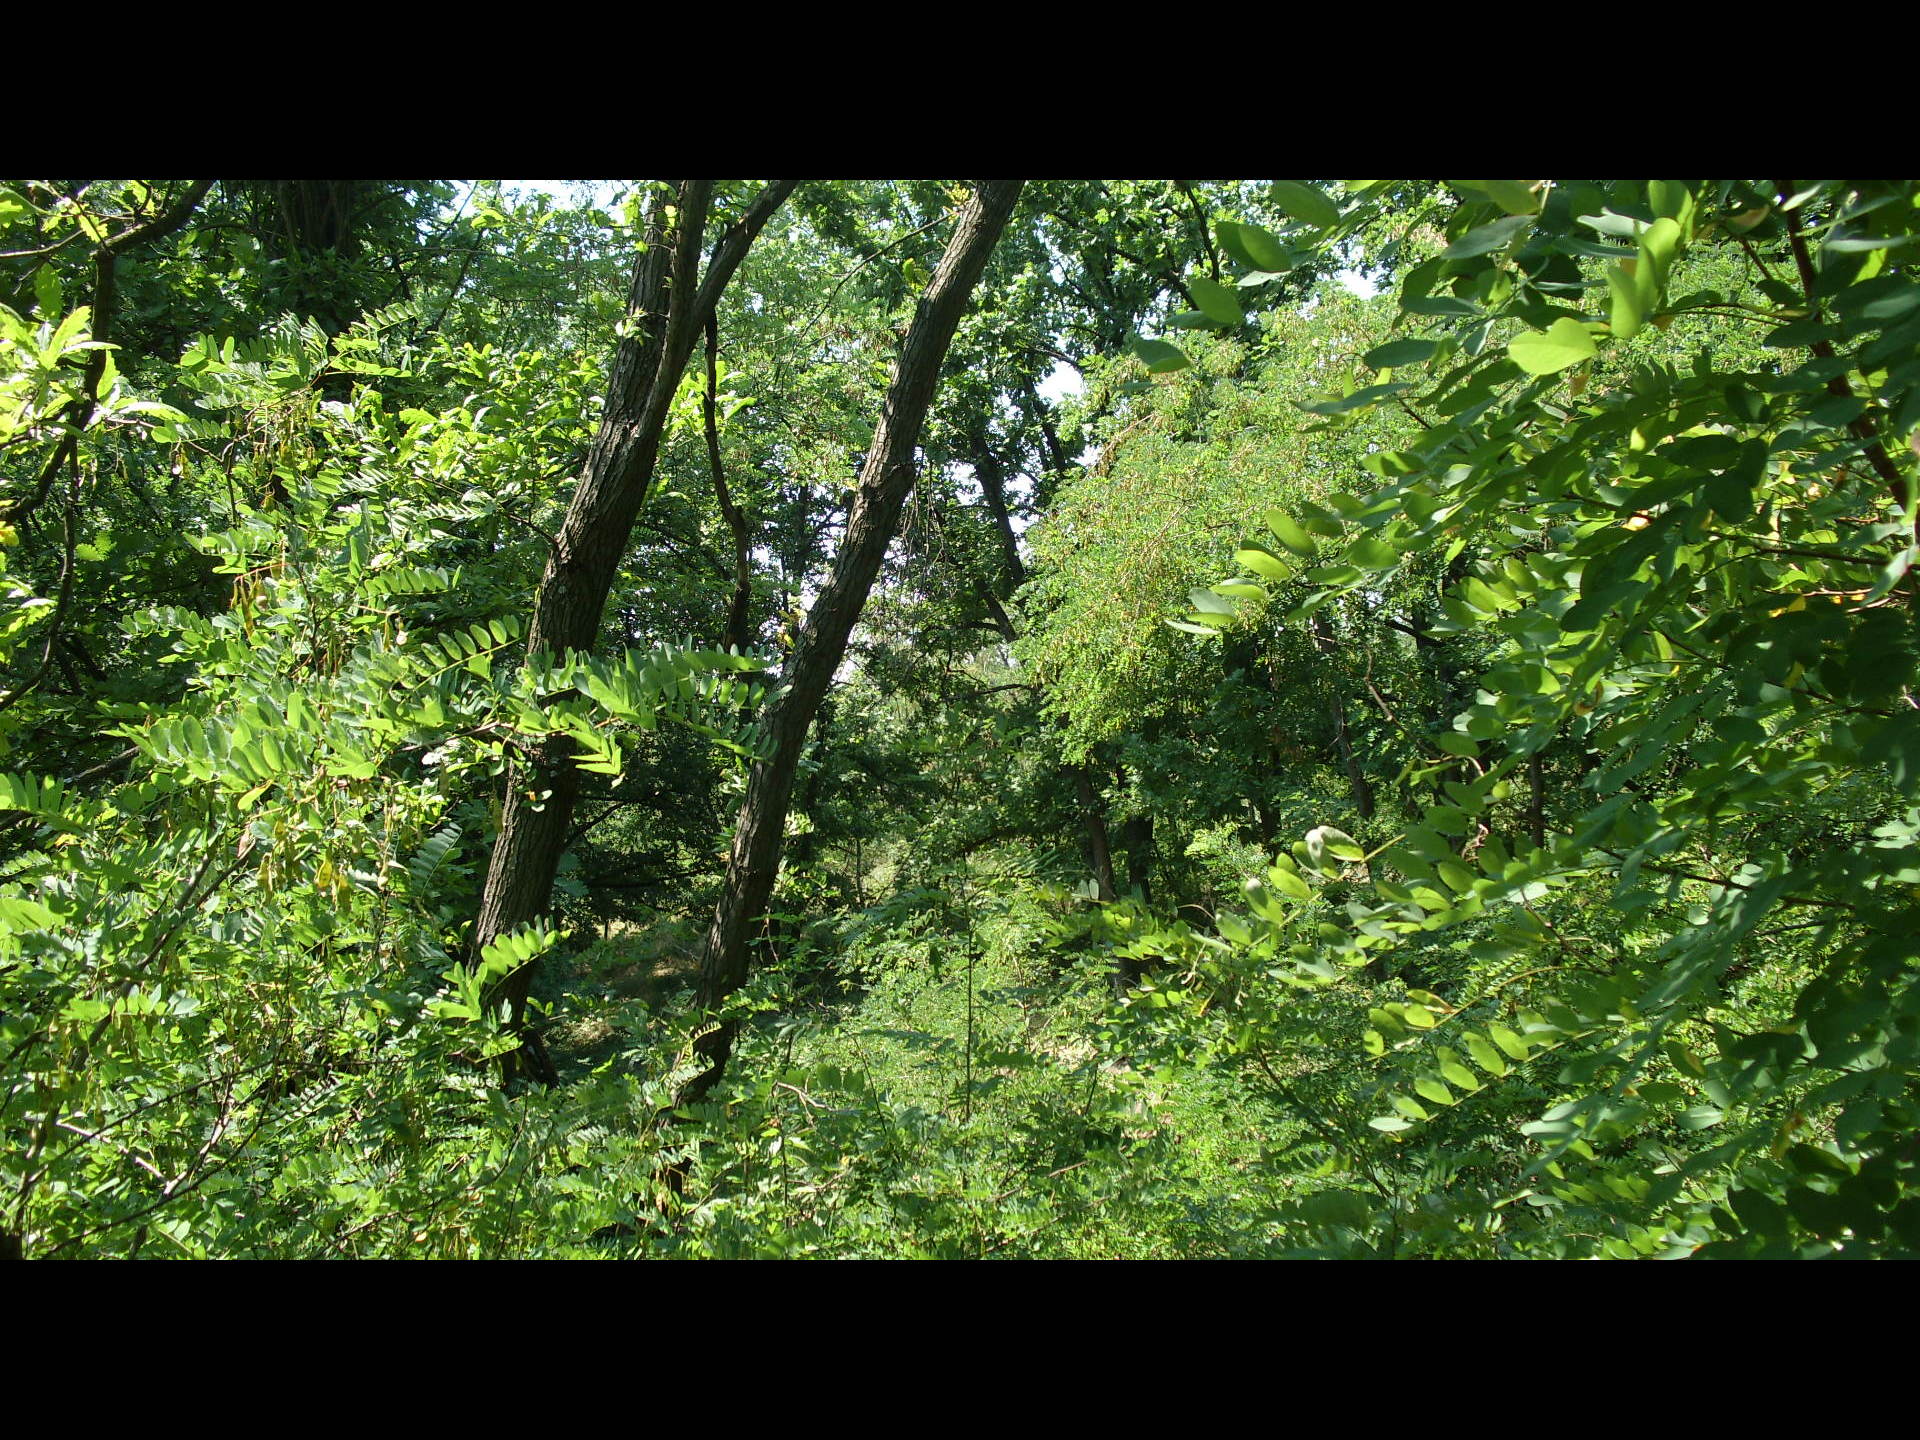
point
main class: Woodland
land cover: Broadleaved woodland
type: mesophytic deciduous forest
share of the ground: > 75 %
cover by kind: broadleaved forest trees 100 %
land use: Forestry
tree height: > 5 m
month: July
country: BG
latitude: 43.7950
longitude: 22.6242
